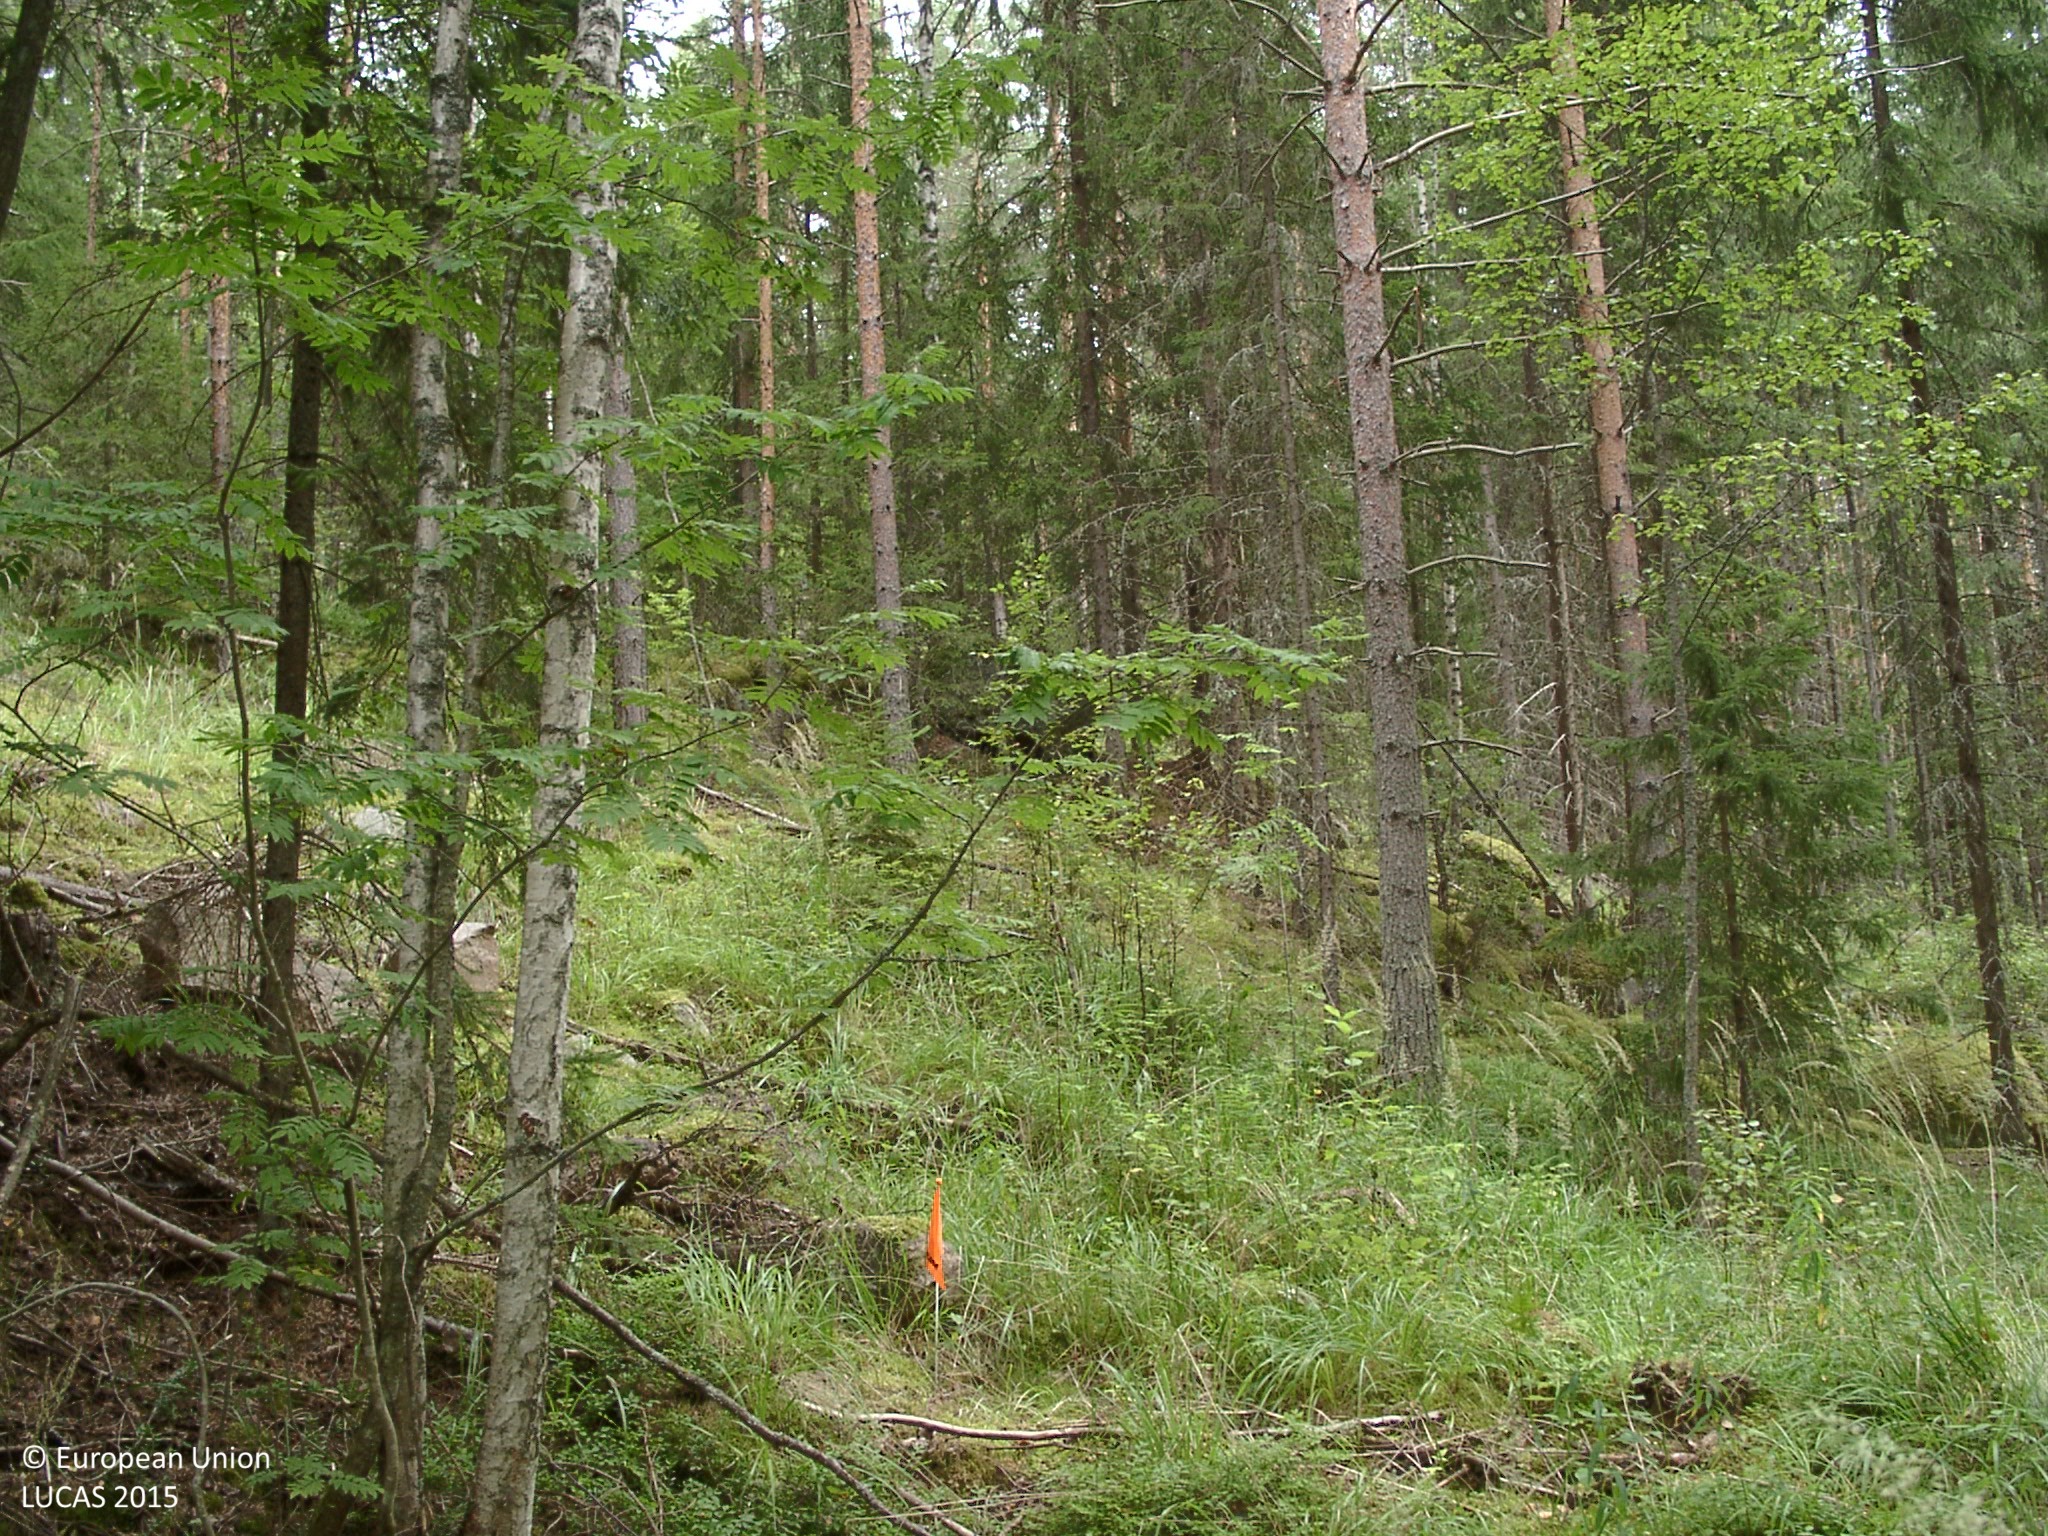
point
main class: Woodland
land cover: Other coniferous woodland
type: boreal forest
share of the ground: > 75 %
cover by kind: coniferous forest trees 60 %, broadleaved forest trees 15 %, lichens and mosses 10 %, unconsolidated bare surface 10 %, shrubs 5 %
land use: Forestry
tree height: > 5 m
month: August
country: FI
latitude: 61.8175
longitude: 25.3561
